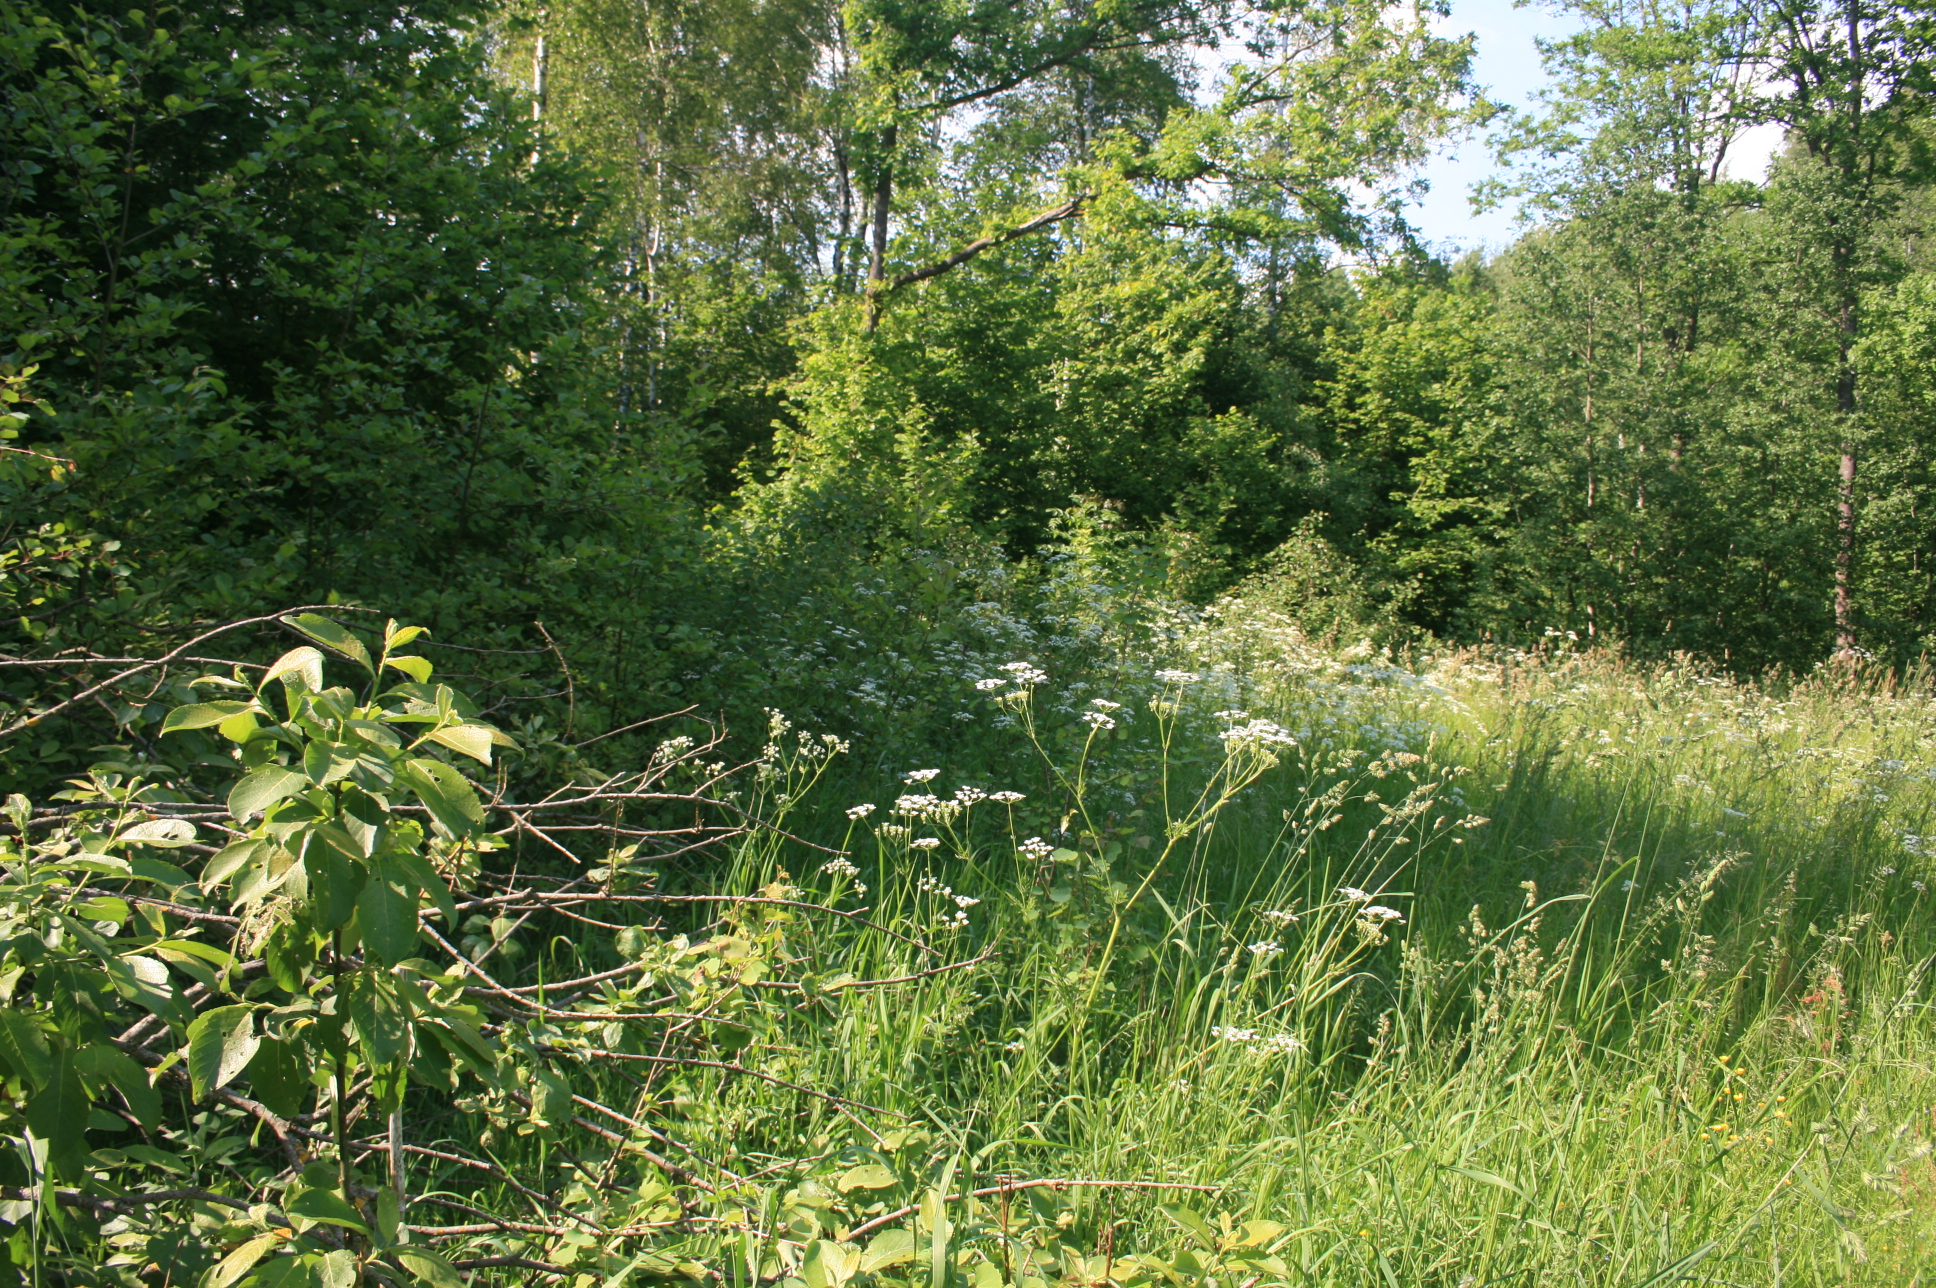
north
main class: Grassland
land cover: Grassland without tree/shrub cover
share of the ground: > 75 %
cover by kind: herbaceous plants 100 %
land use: Agriculture (excluding fallow land and kitchen gardens)
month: June
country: LT
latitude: 55.5885
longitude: 22.1613
